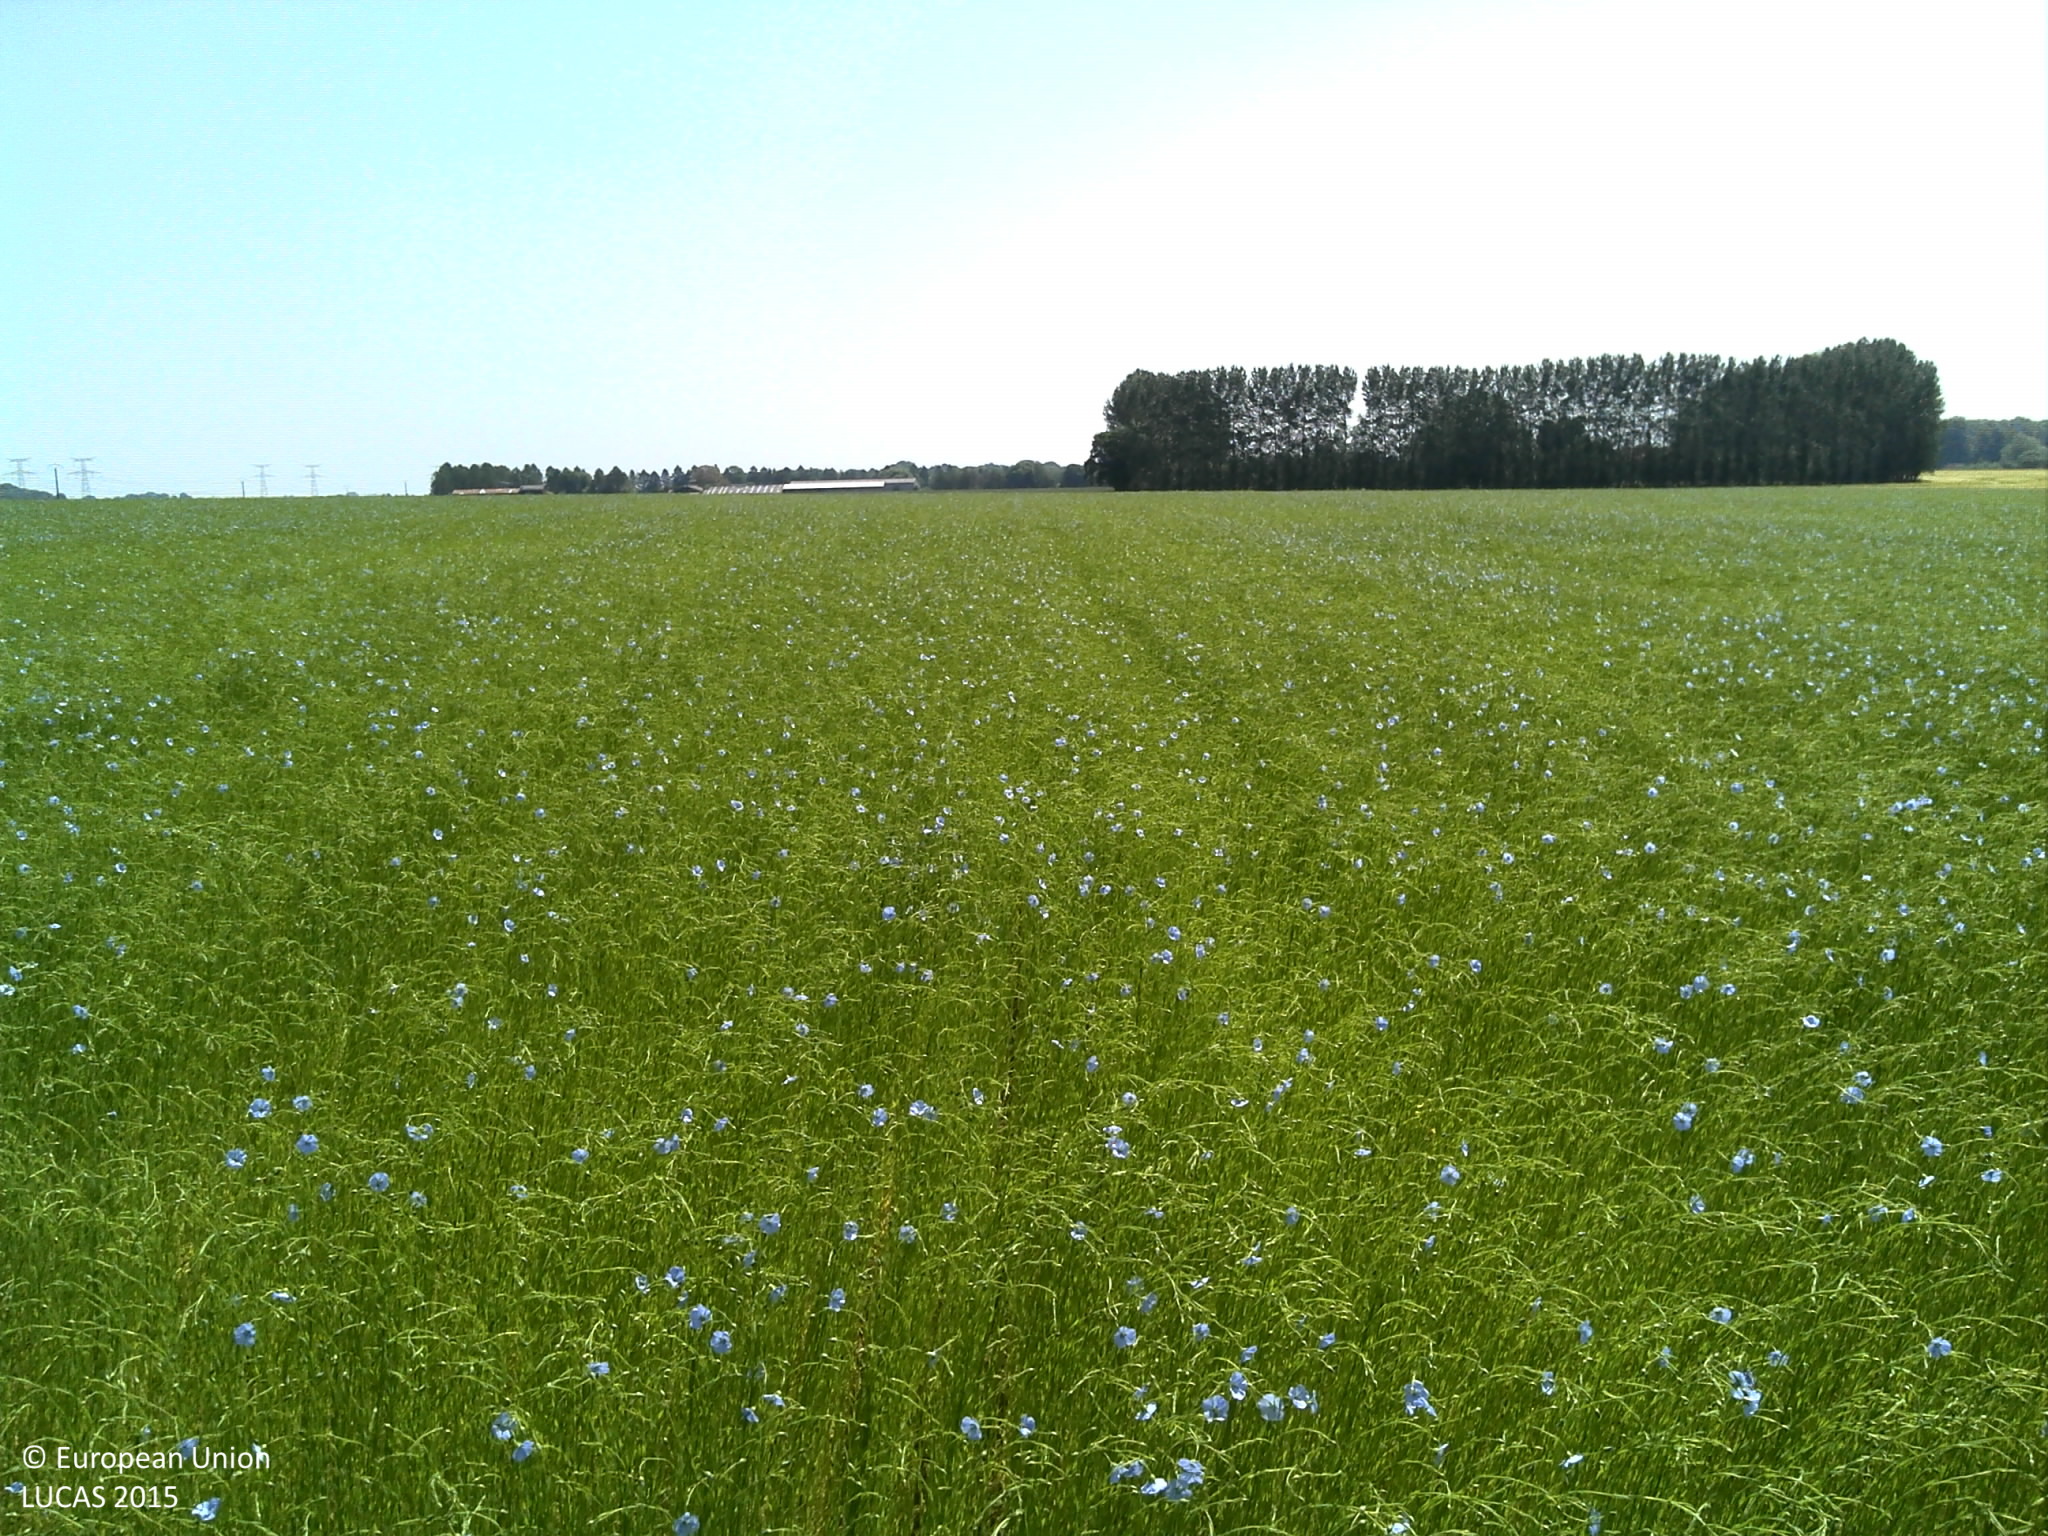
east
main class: Cropland
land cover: Other fibre and oleaginous crops
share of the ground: > 75 %
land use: Agriculture (excluding fallow land and kitchen gardens)
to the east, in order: Other fibre and oleaginous crops
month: June
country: FR
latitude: 49.5876
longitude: 1.1675
